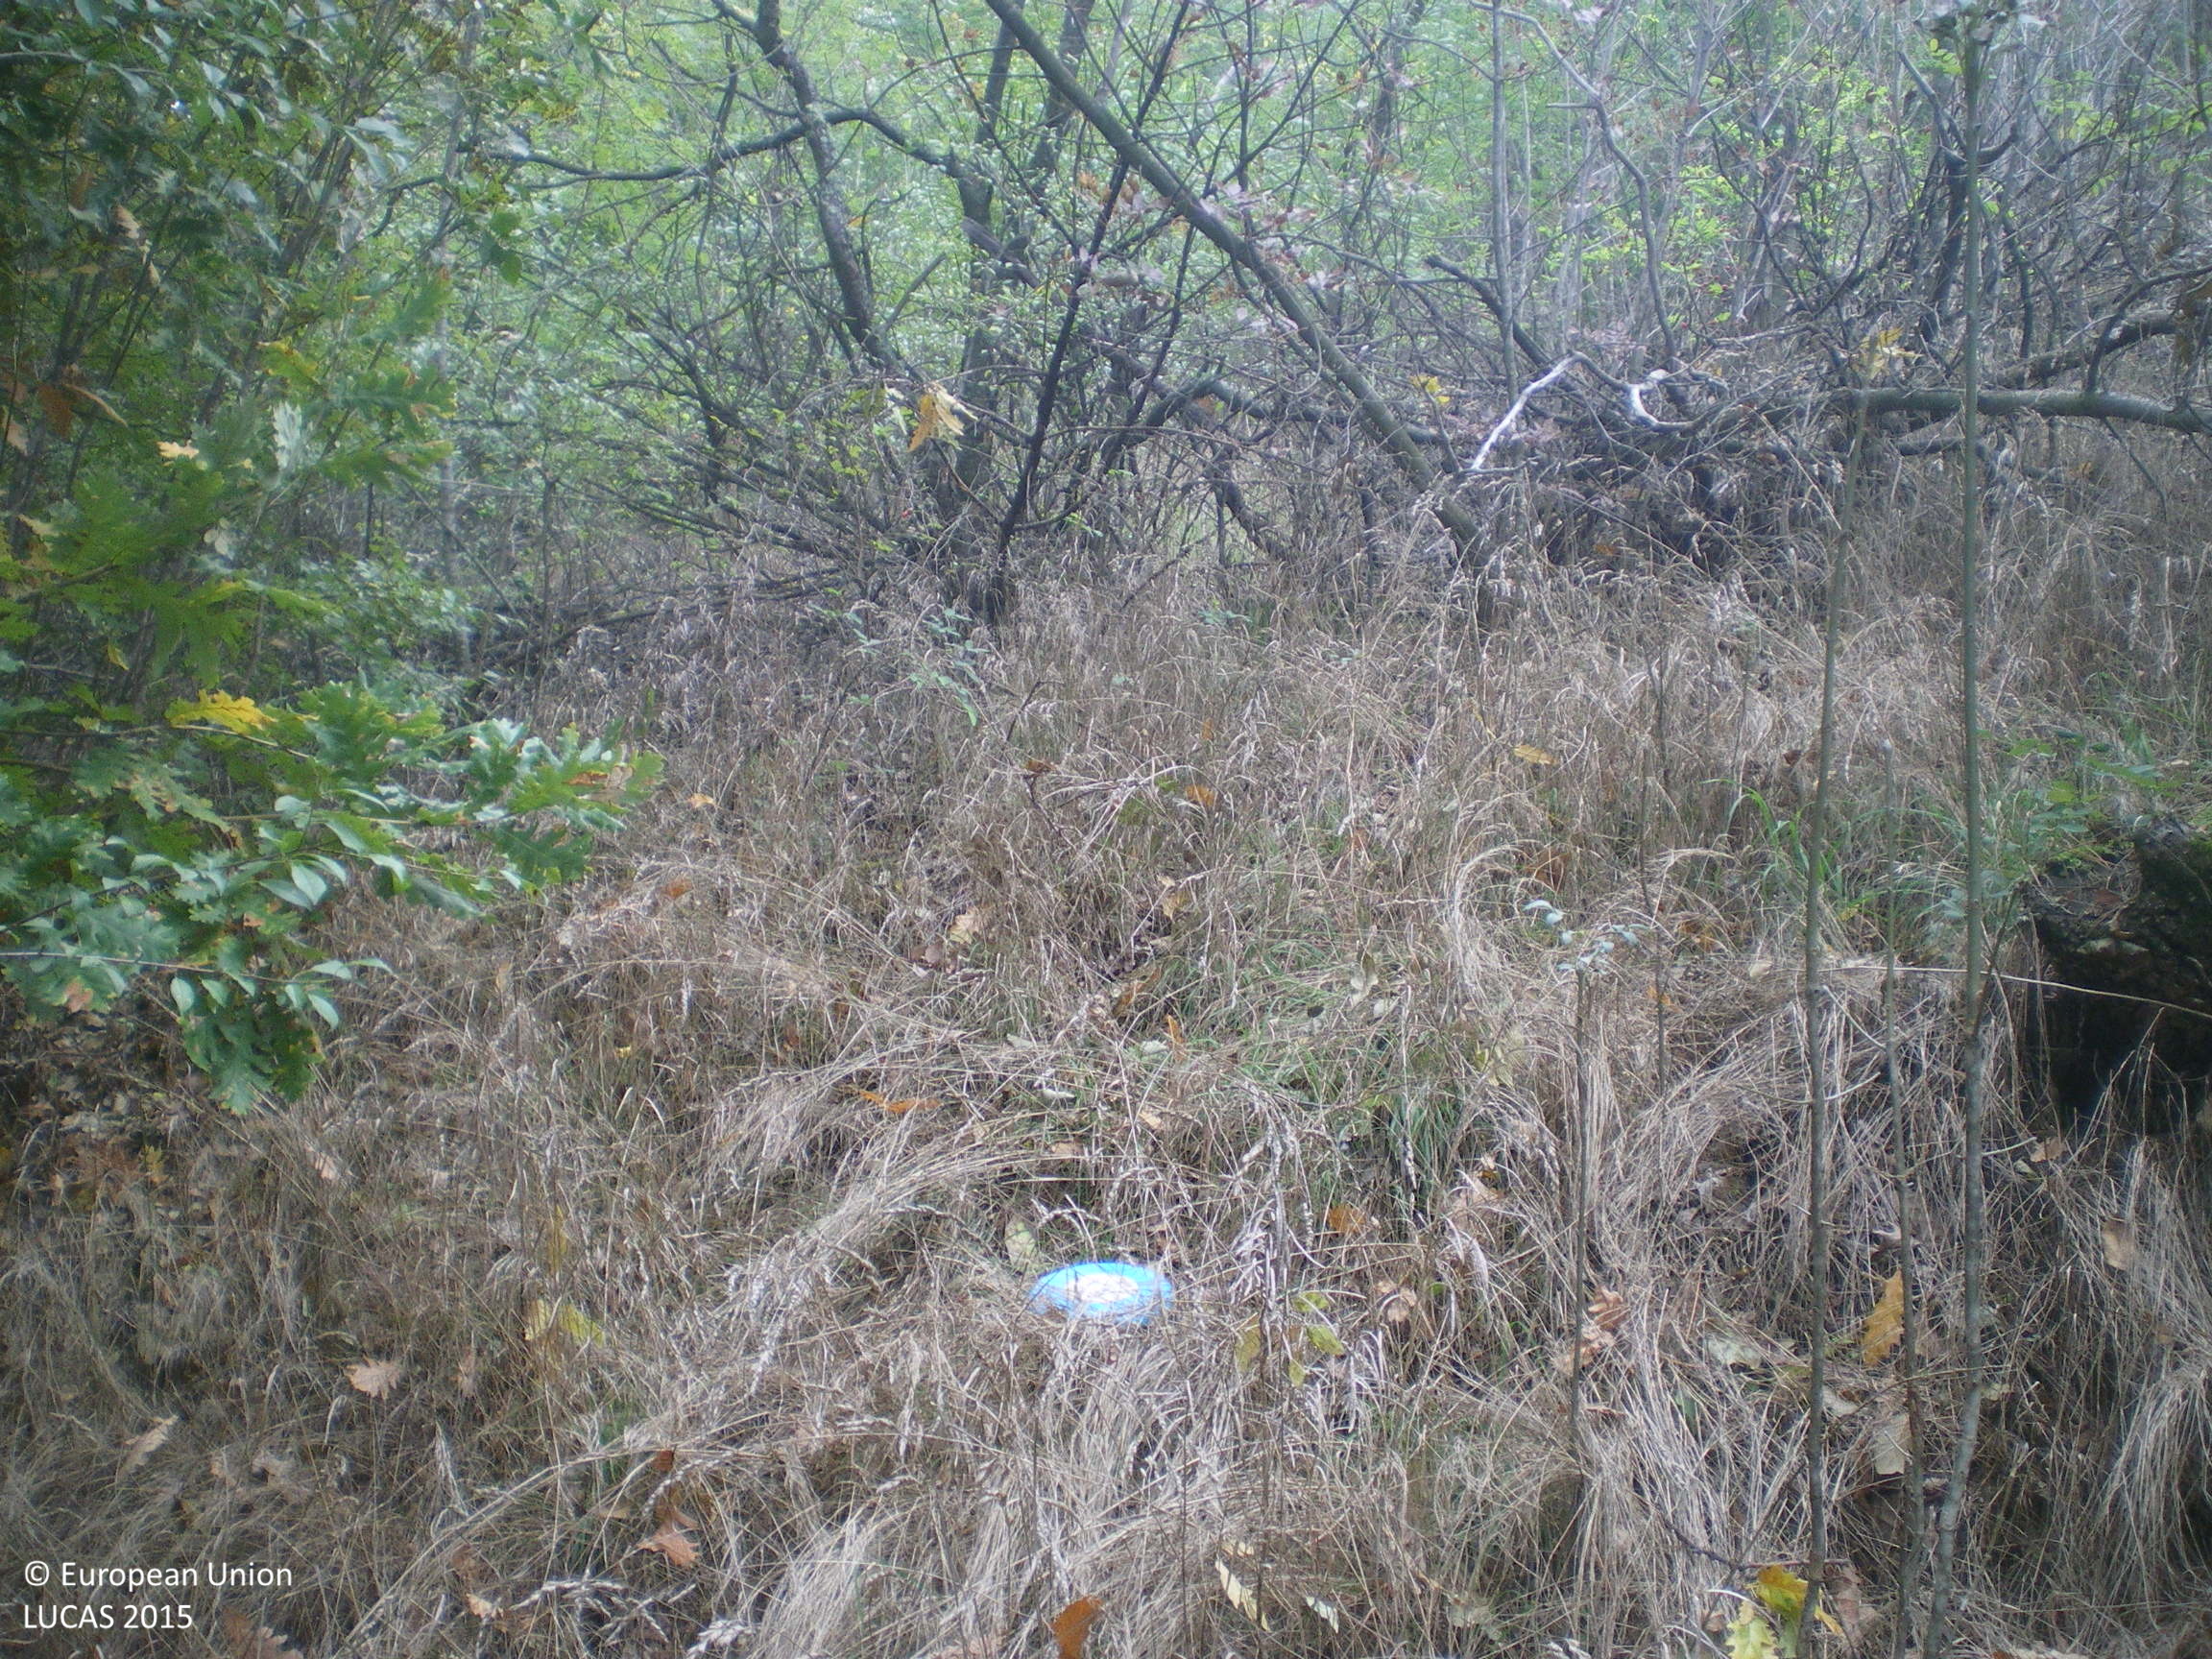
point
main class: Woodland
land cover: Other mixed woodland
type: hemiboreal forest and nemoral coniferous forest and mixed broadleaved-coniferous forest
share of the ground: > 75 %
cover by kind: coniferous forest trees 65 %, broadleaved forest trees 25 %, shrubs 10 %
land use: Forestry
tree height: > 5 m
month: October
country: BG
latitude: 42.6758
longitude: 25.6585
